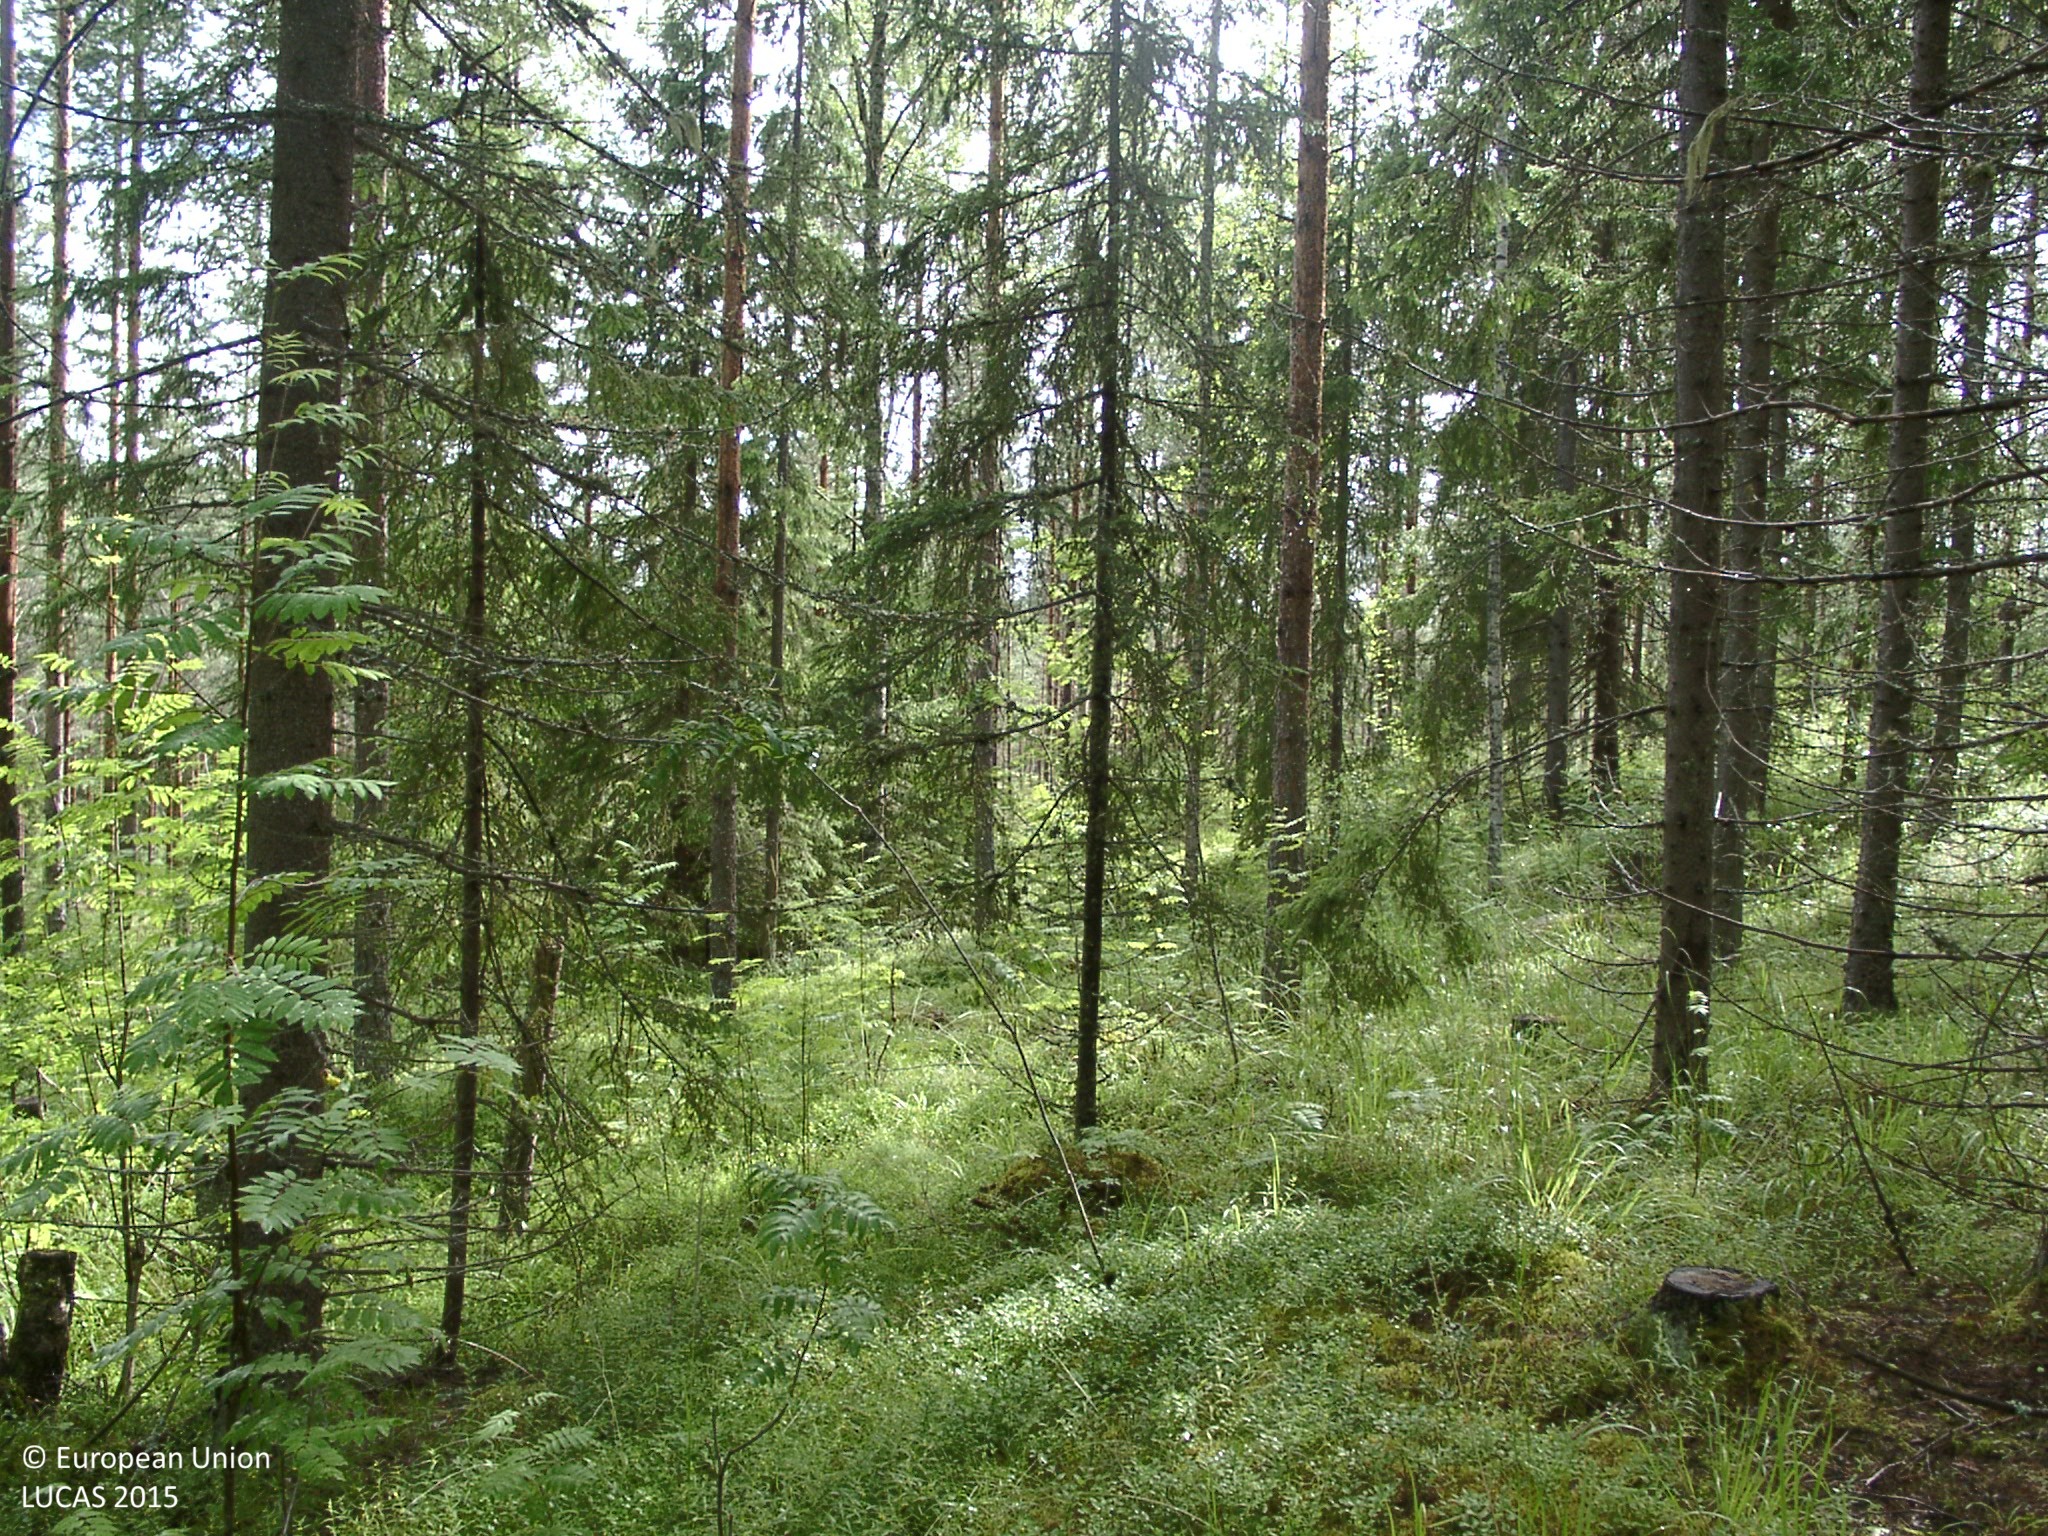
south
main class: Woodland
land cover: Other coniferous woodland
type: boreal forest
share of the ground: 50 - 75 %
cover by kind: coniferous forest trees 55 %, broadleaved forest trees 15 %, shrubs 15 %, lichens and mosses 10 %, herbaceous plants 5 %
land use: Forestry
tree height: > 5 m
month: July
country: FI
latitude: 61.9207
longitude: 25.2517
